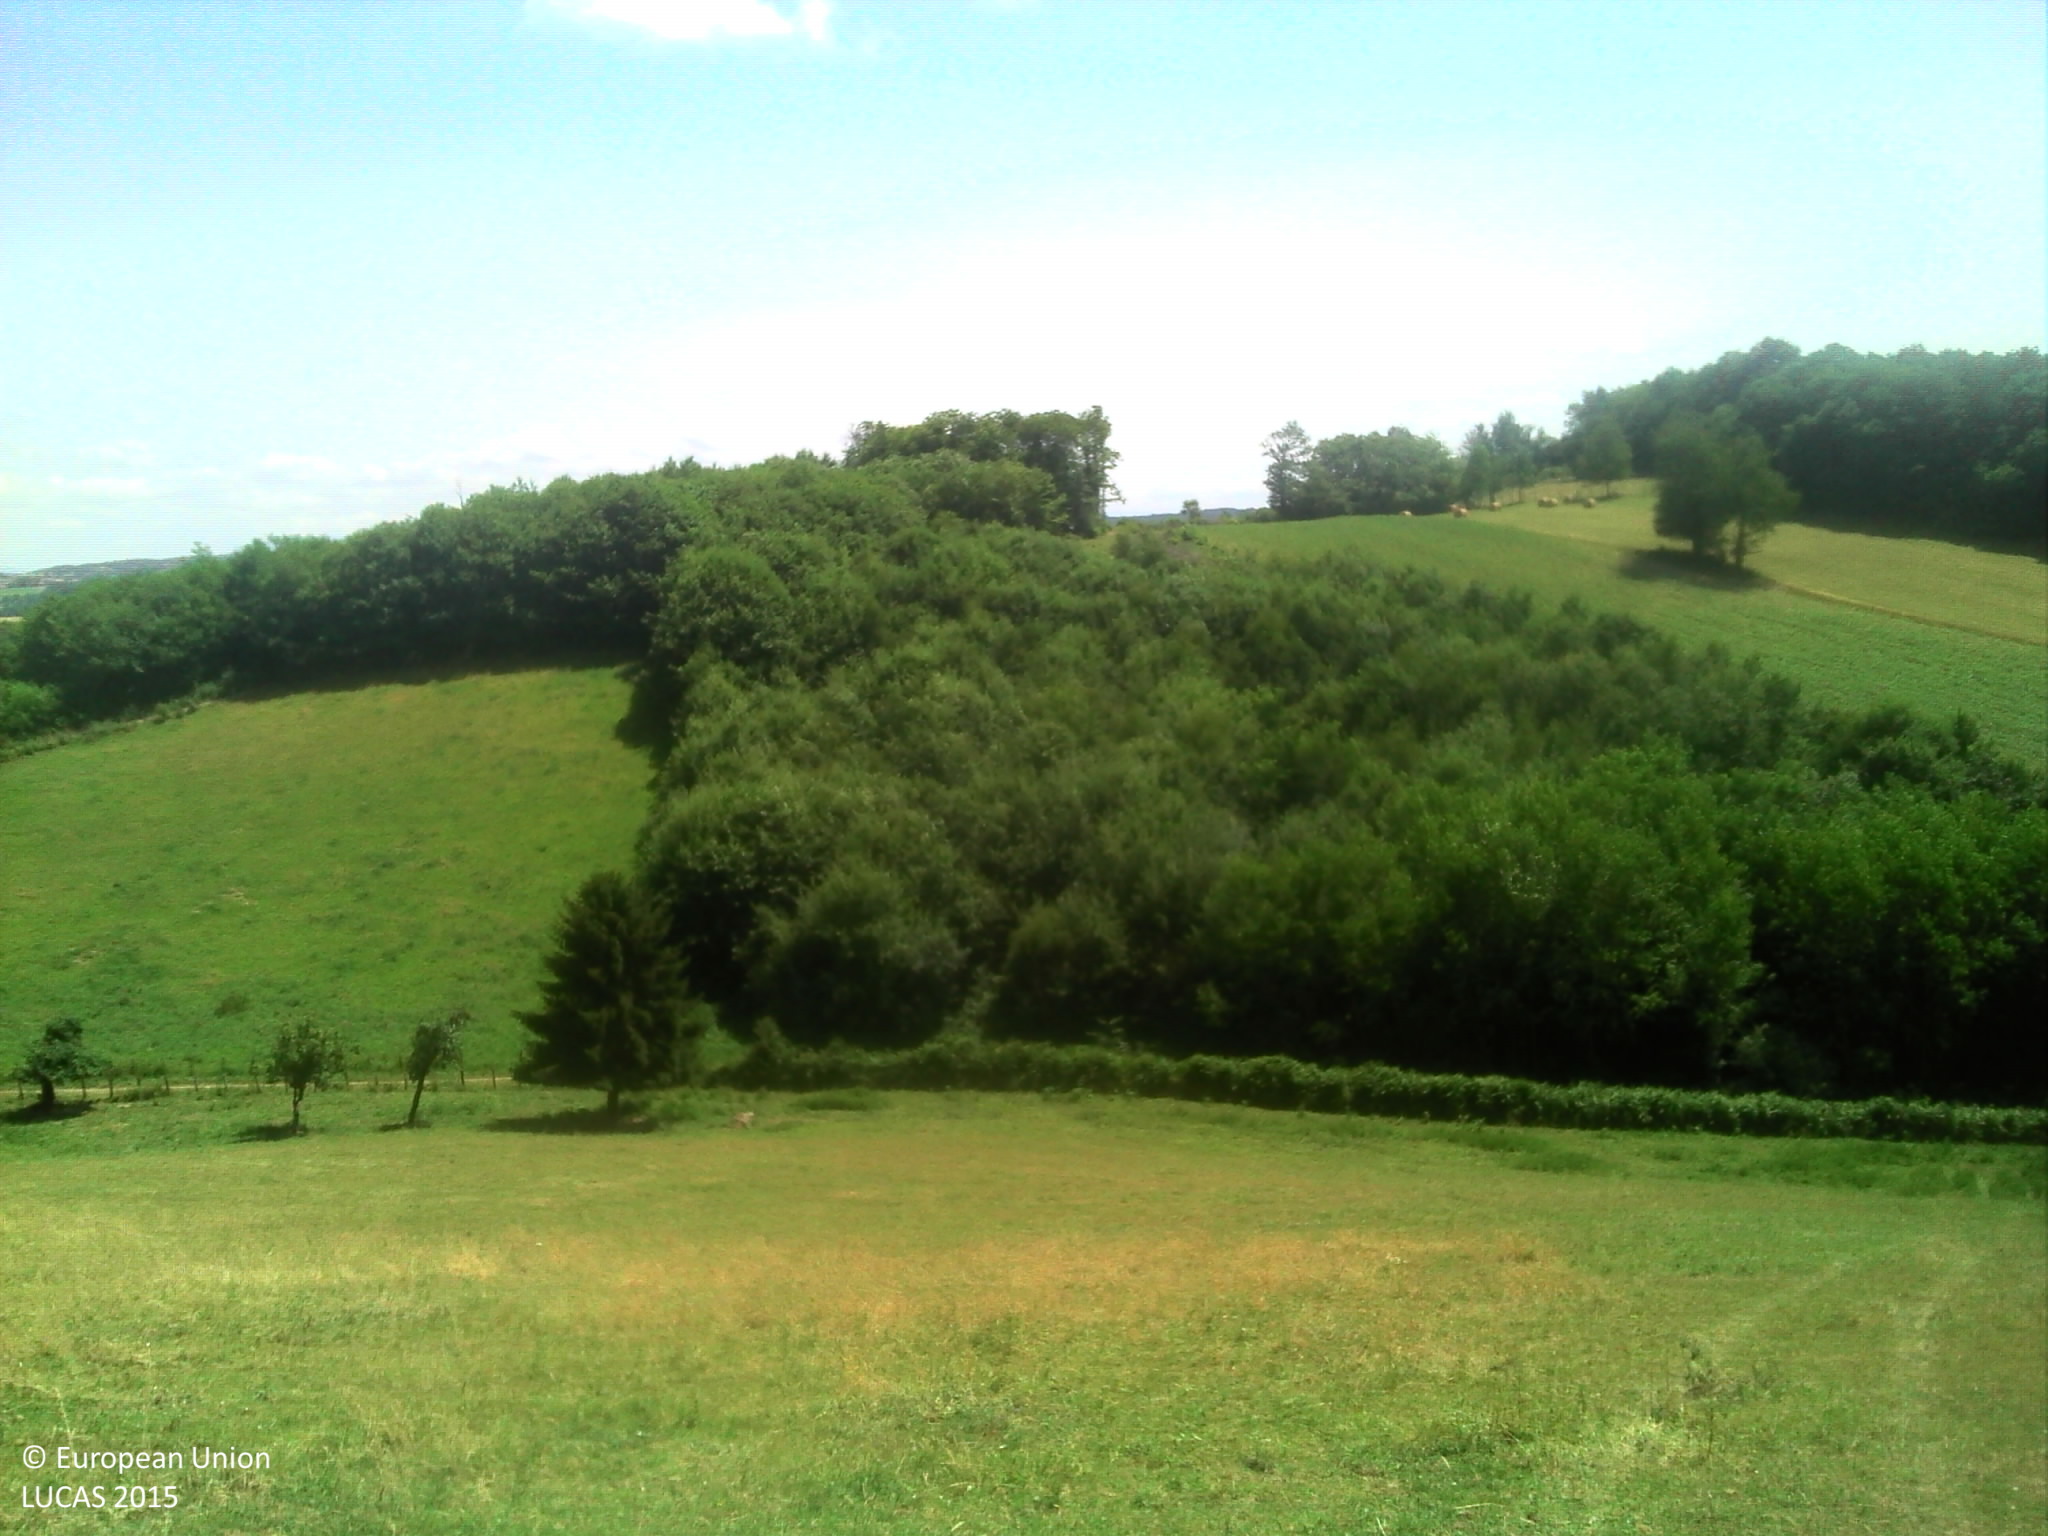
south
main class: Grassland
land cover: Grassland without tree/shrub cover
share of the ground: > 75 %
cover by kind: herbaceous plants 100 %
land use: Agriculture (excluding fallow land and kitchen gardens)
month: July
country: FR
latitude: 45.5206
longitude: 5.1780
